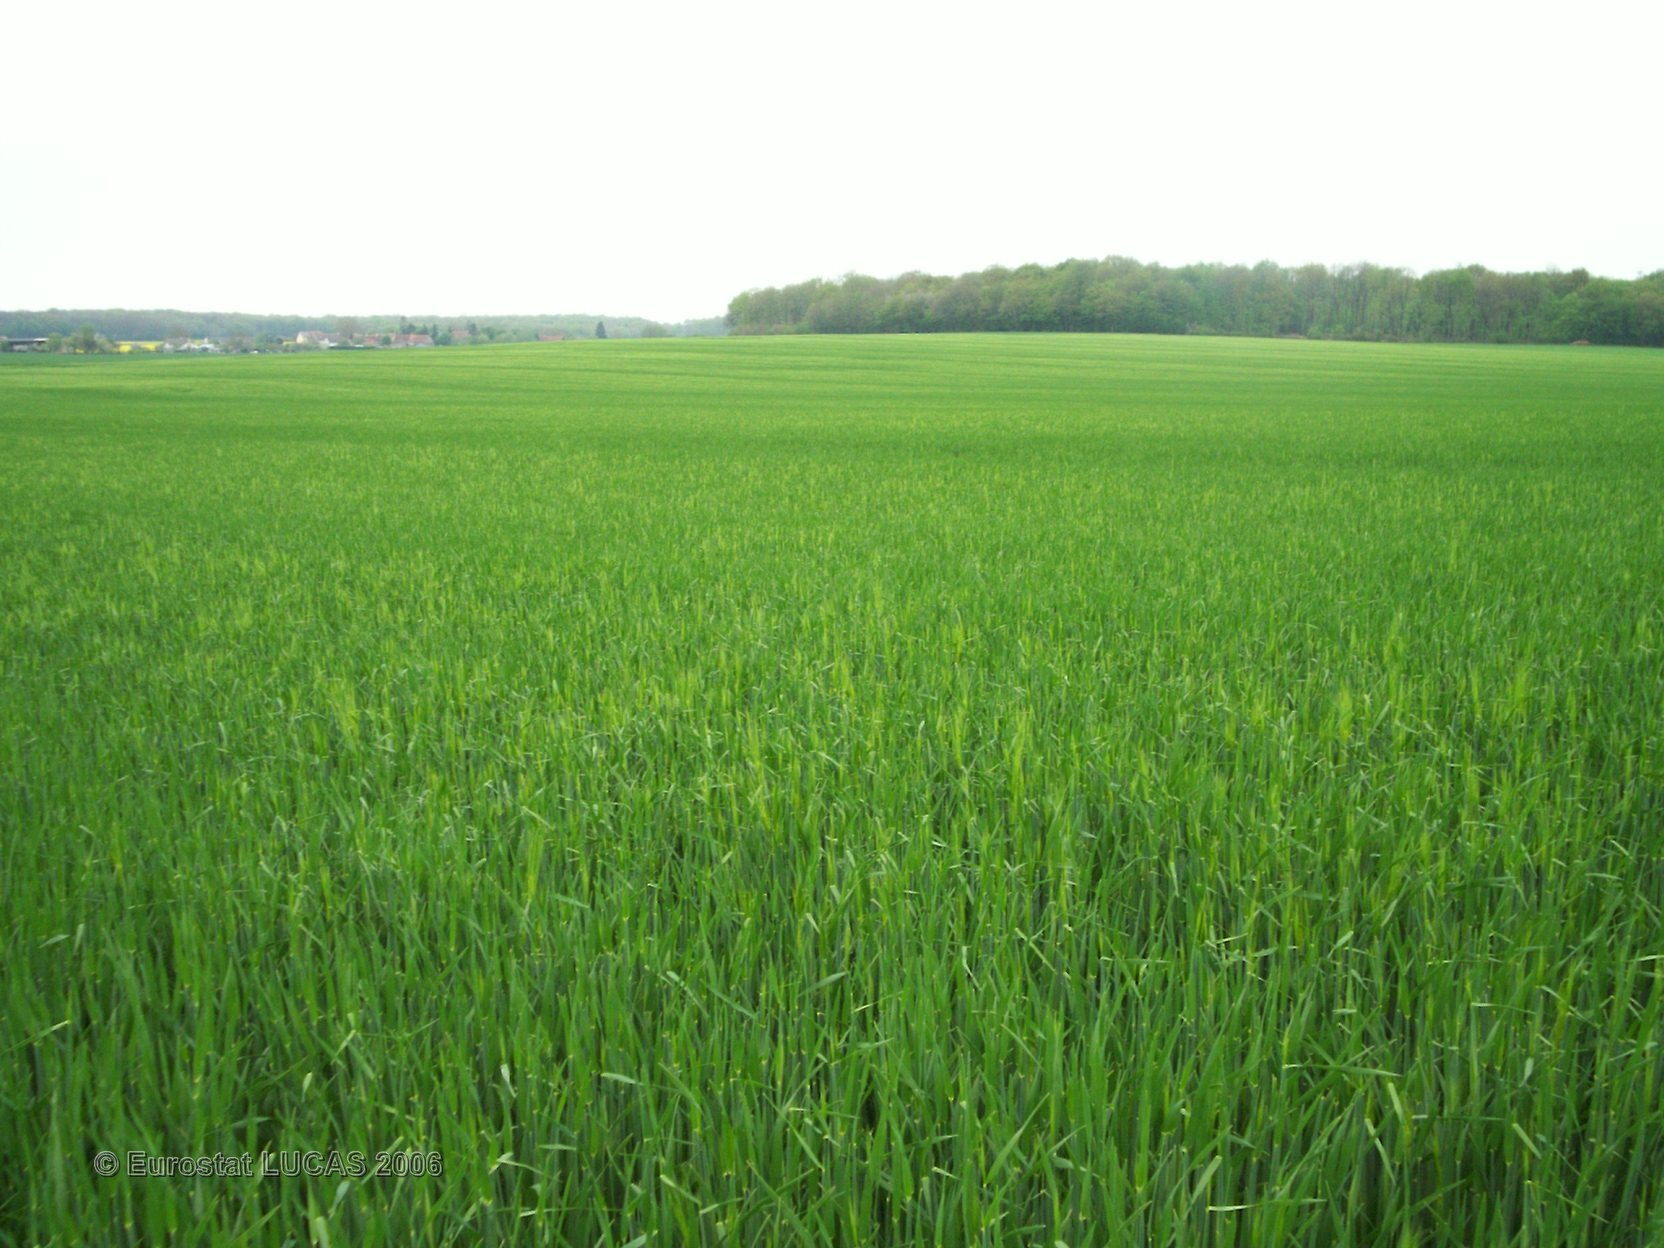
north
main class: Cropland
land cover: Barley
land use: Agriculture (excluding fallow land and kitchen gardens)
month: April
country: FR
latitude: 46.9032
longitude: 1.5475
